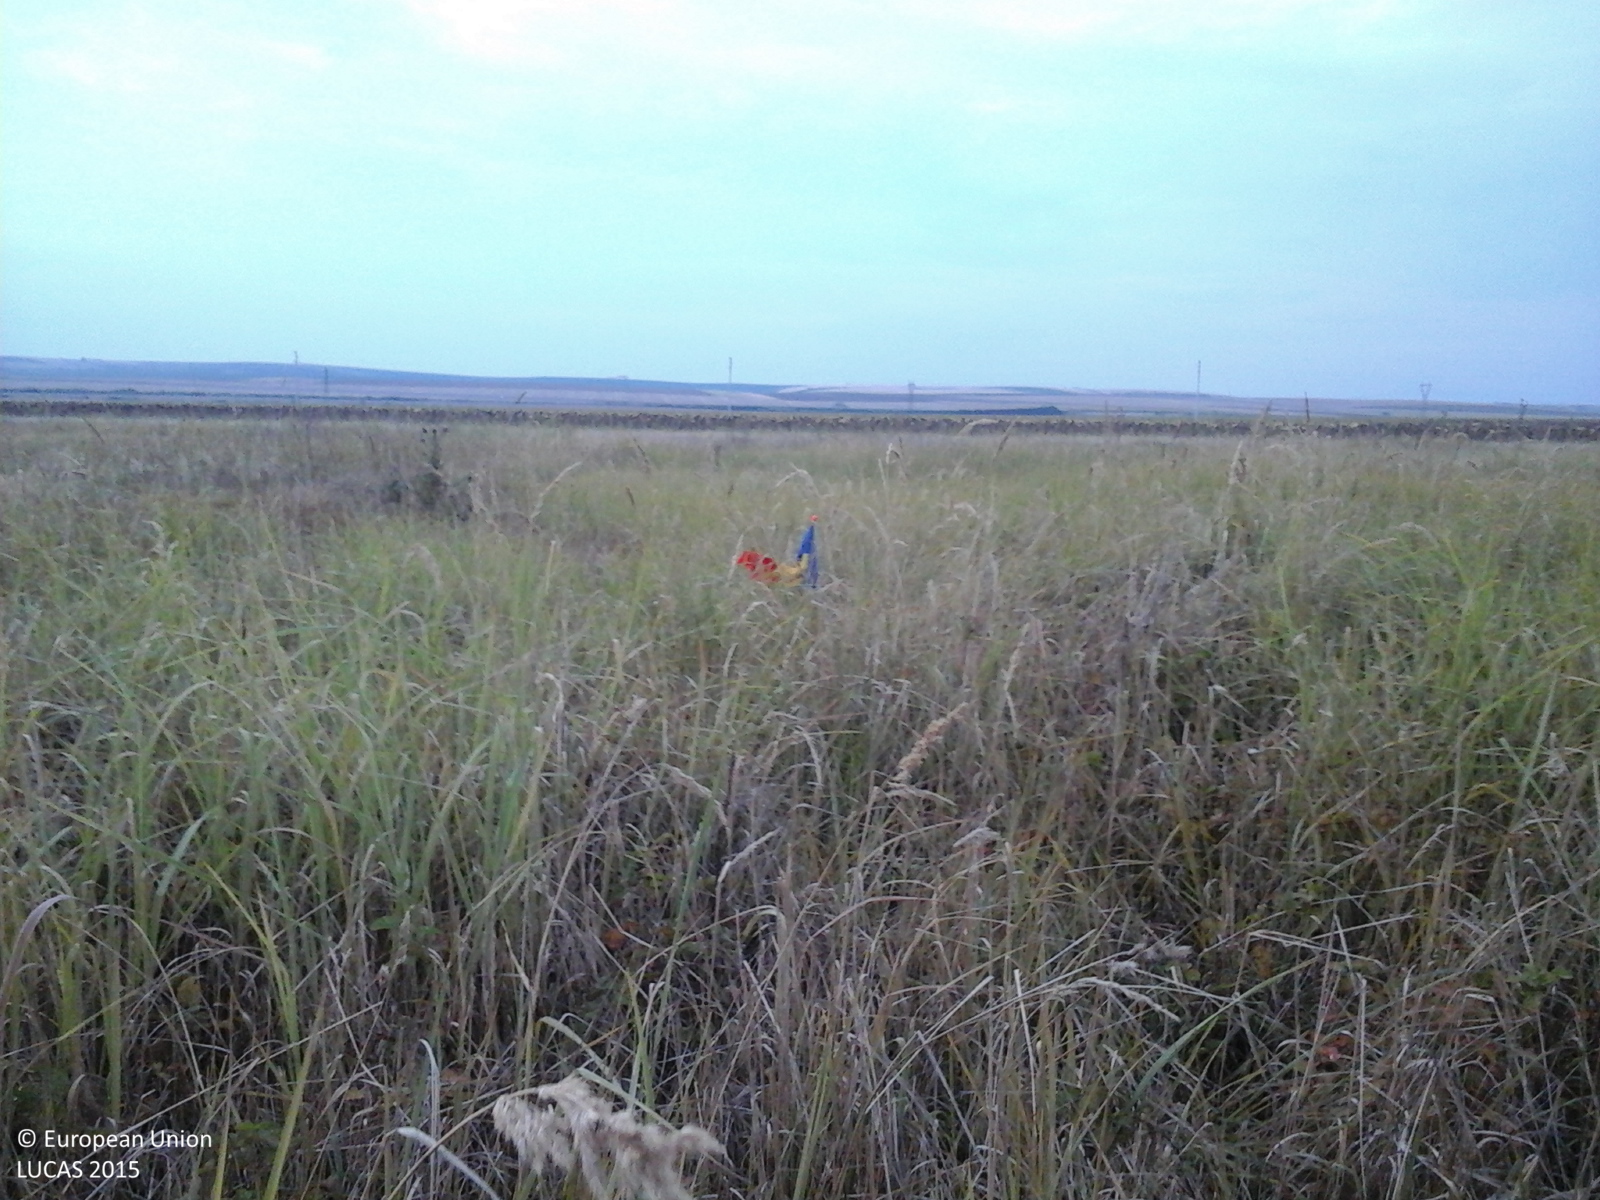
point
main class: Grassland
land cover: Spontaneously vegetated surfaces
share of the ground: > 75 %
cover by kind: herbaceous plants 100 %
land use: Fallow land
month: August
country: RO
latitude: 45.7961
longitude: 21.5490
